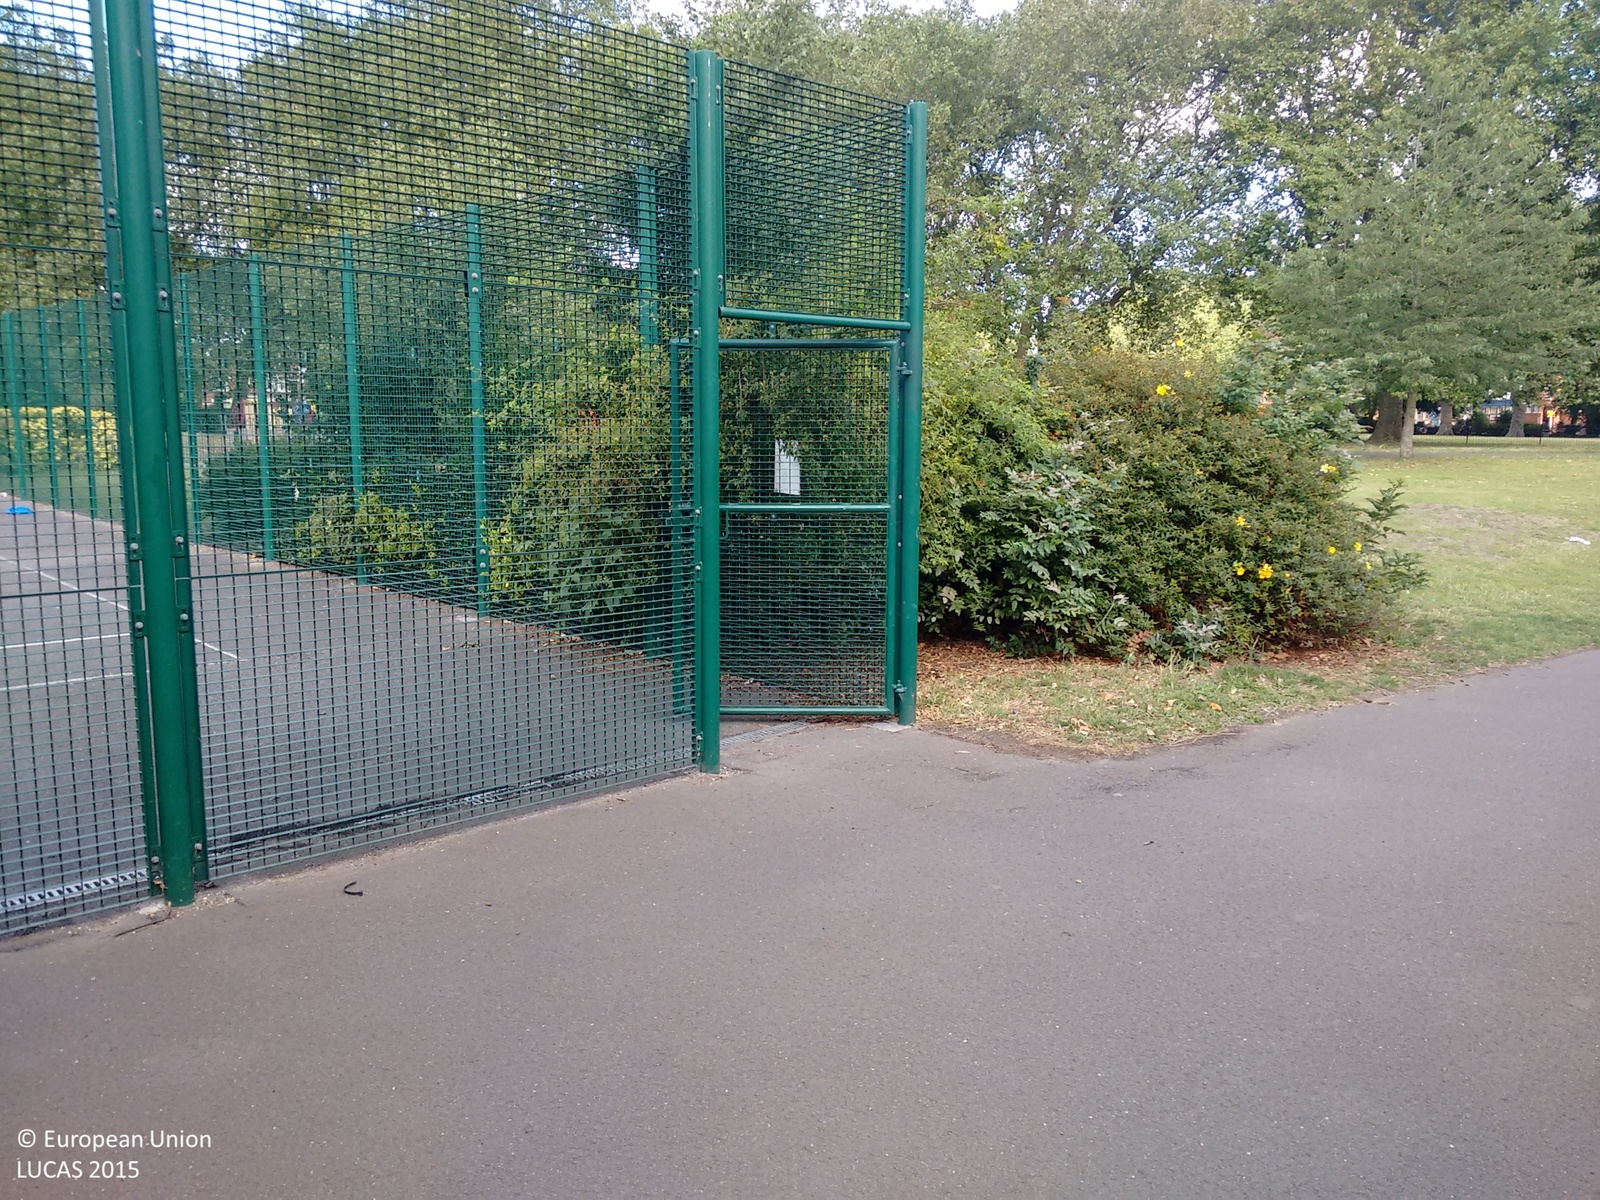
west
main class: Shrubland
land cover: Shrubland with sparse tree cover
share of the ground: > 75 %
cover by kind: shrubs 75 %, herbaceous plants 20 %, broadleaved forest trees 5 %
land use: Residential
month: July
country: GB
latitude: 51.4824
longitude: -0.2159
